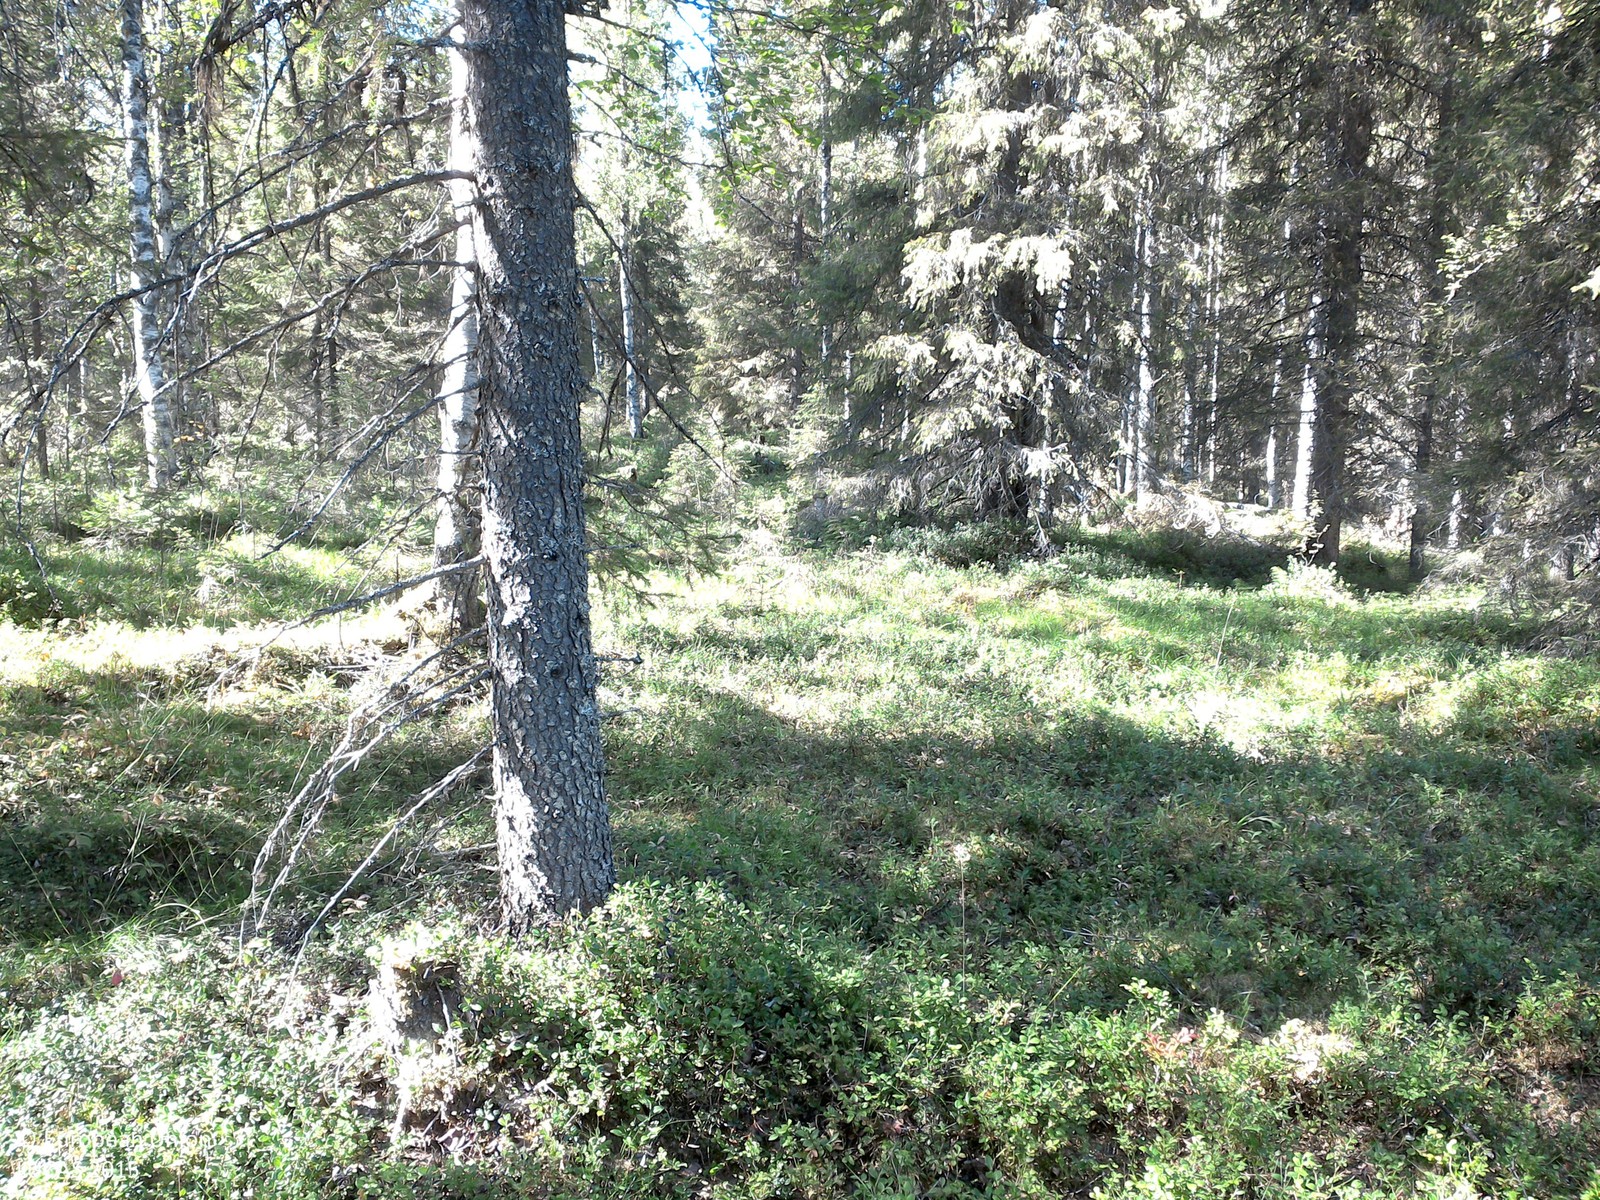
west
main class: Woodland
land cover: Spruce dominated mixed woodland
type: boreal forest
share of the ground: 25 - 50 %
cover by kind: shrubs 60 %, coniferous forest trees 20 %, broadleaved forest trees 15 %, lichens and mosses 5 %
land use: Forestry
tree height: > 5 m
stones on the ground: > 50 %
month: August
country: SE
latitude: 67.1349
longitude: 21.4159
